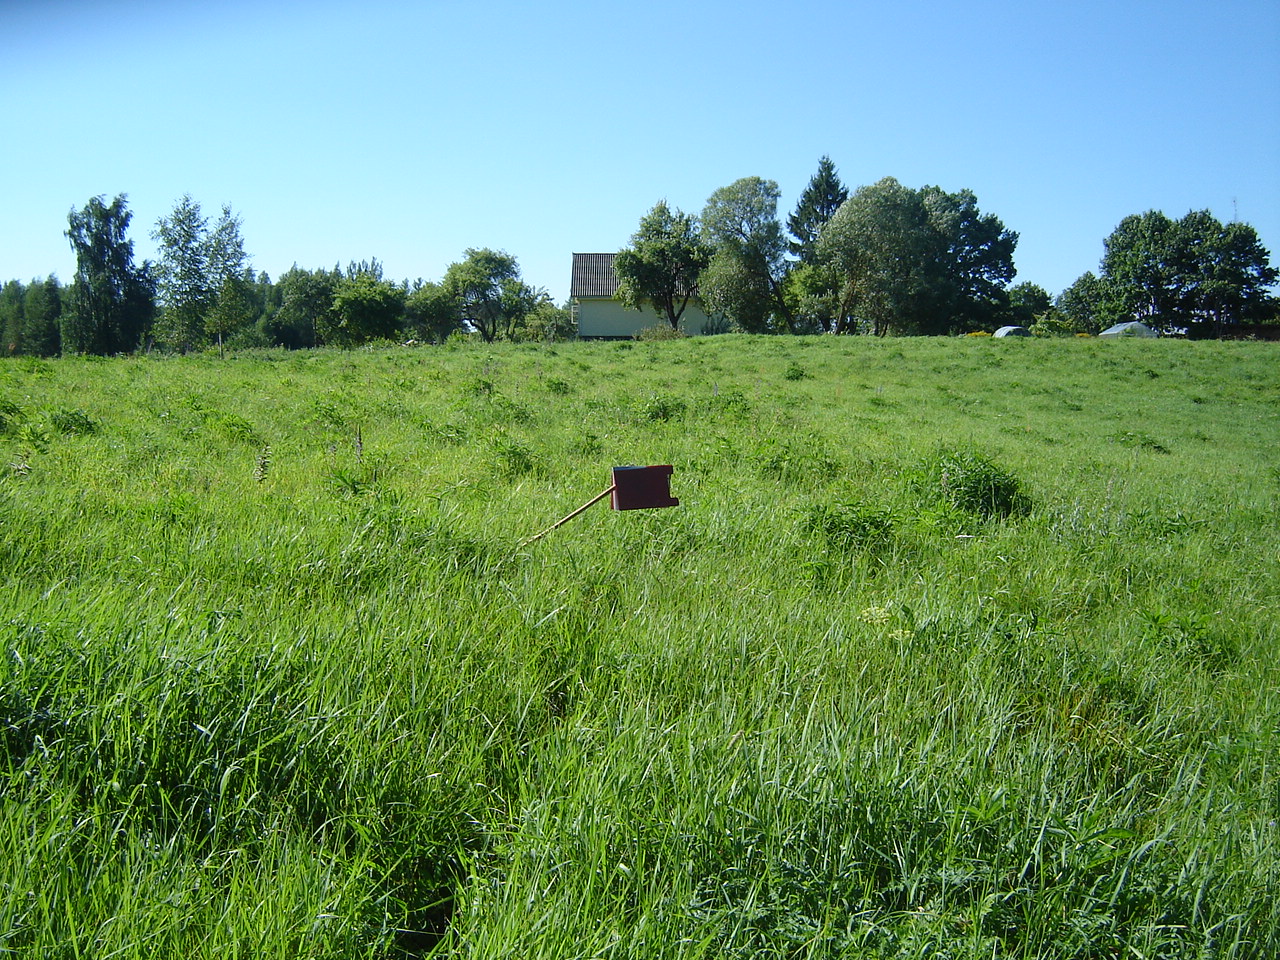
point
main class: Grassland
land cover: Grassland without tree/shrub cover
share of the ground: > 75 %
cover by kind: herbaceous plants 100 %
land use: Agriculture (excluding fallow land and kitchen gardens)
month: August
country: LT
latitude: 54.9763
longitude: 25.3876
